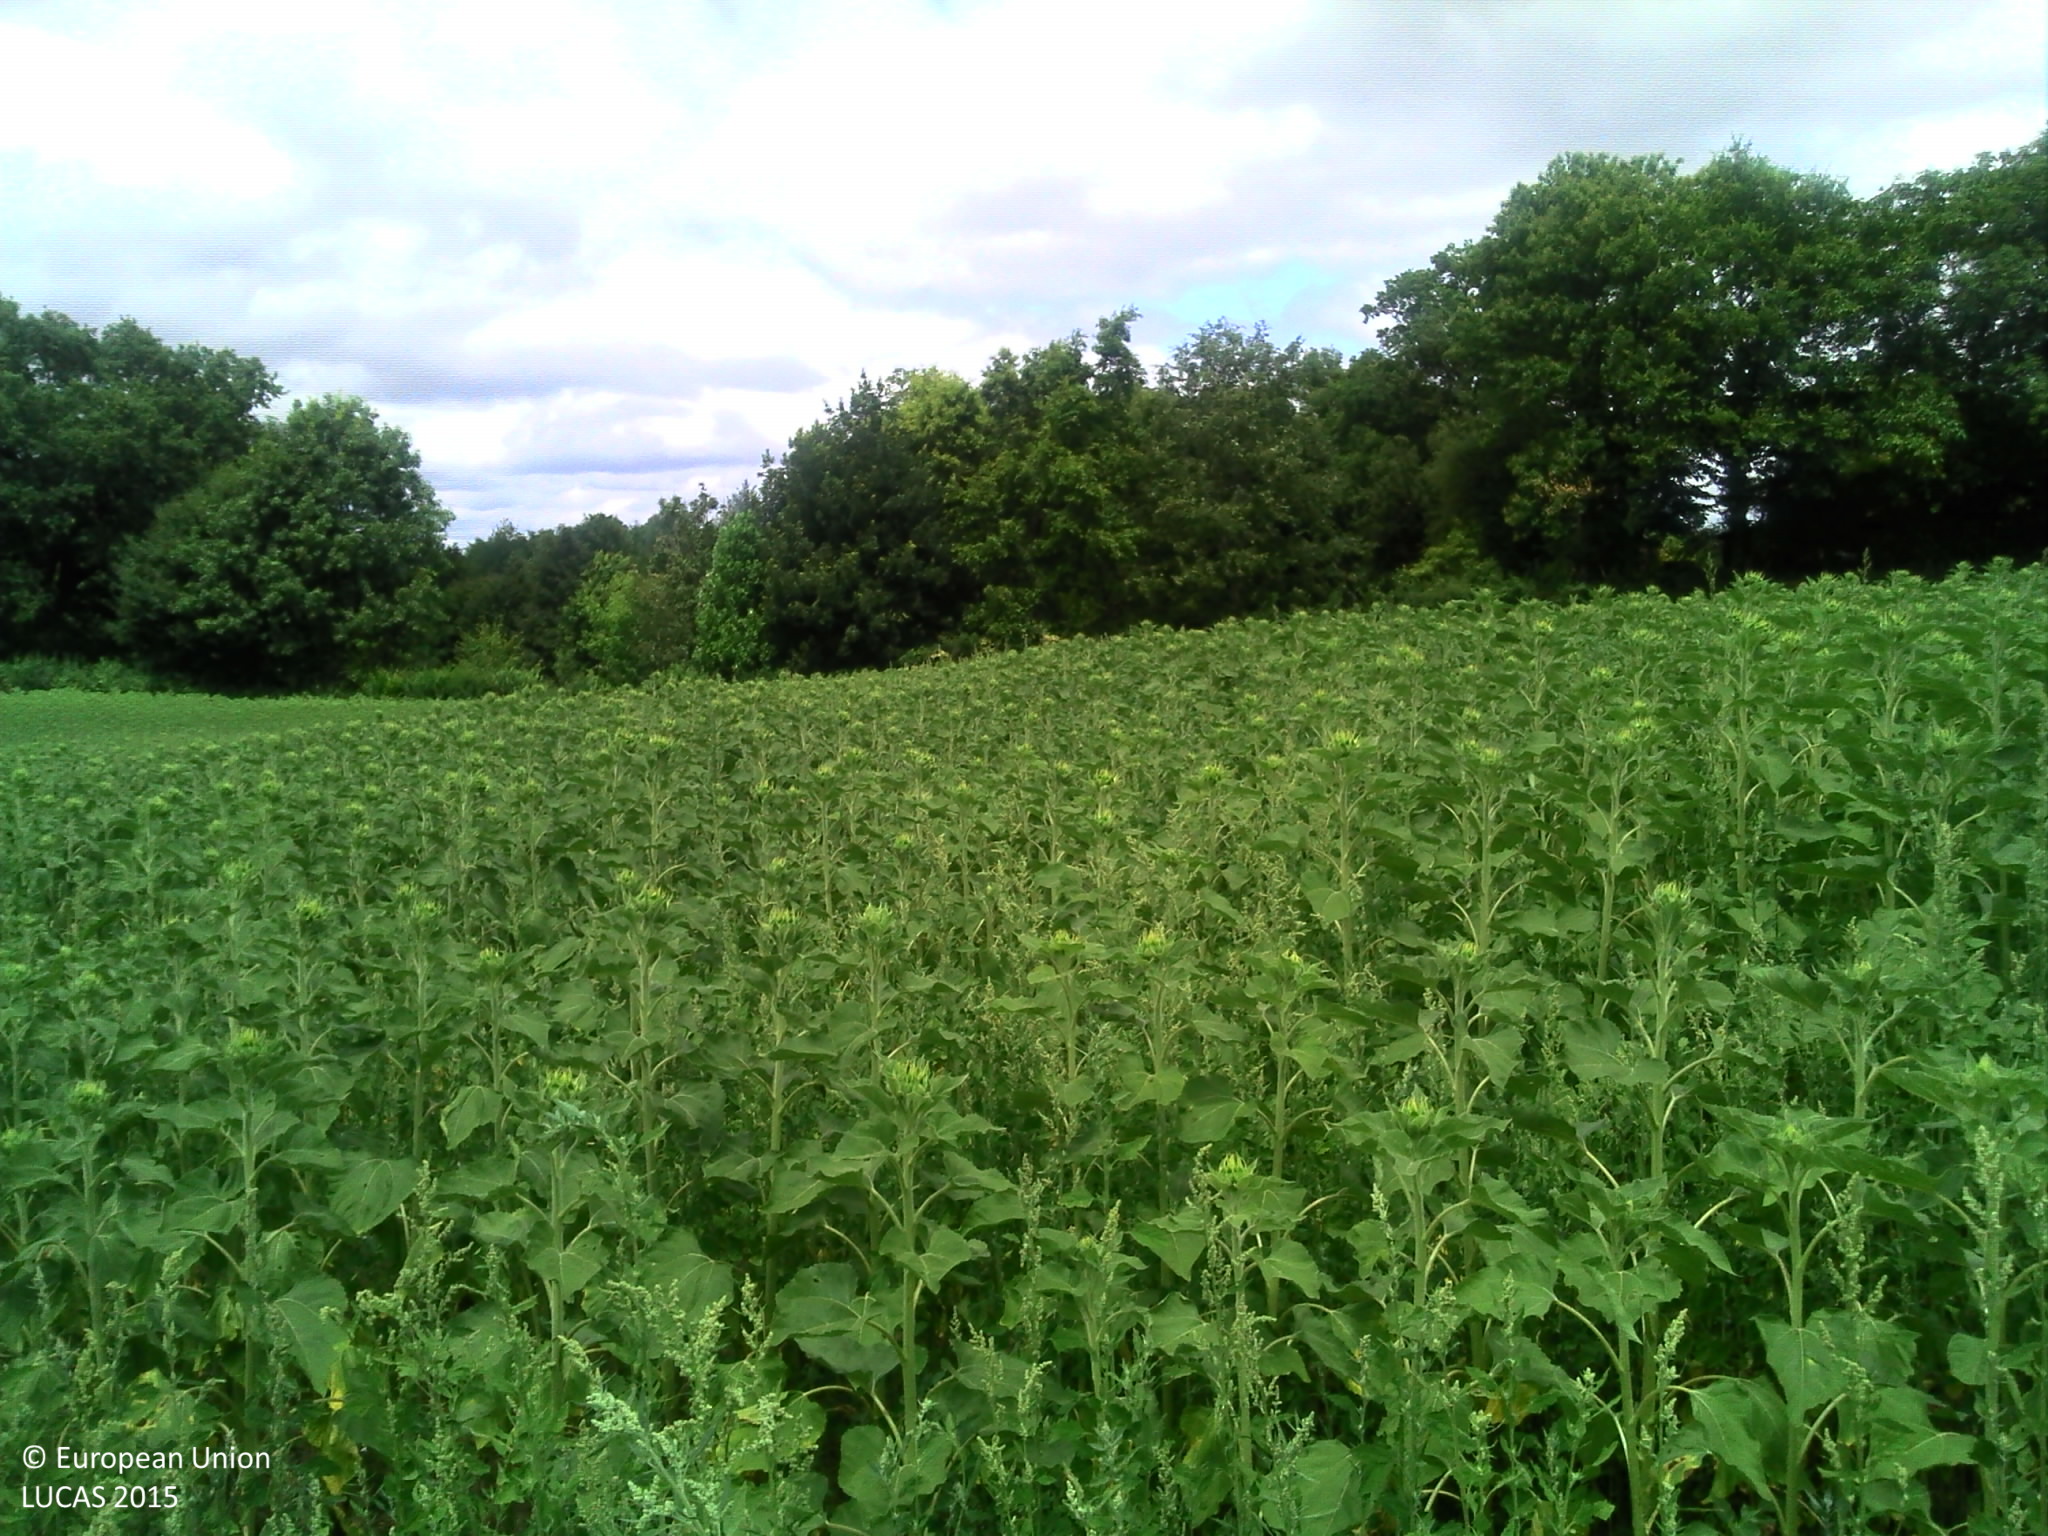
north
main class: Cropland
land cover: Sunflower
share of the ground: > 75 %
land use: Agriculture (excluding fallow land and kitchen gardens)
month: July
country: FR
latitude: 46.3649
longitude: 1.6071
